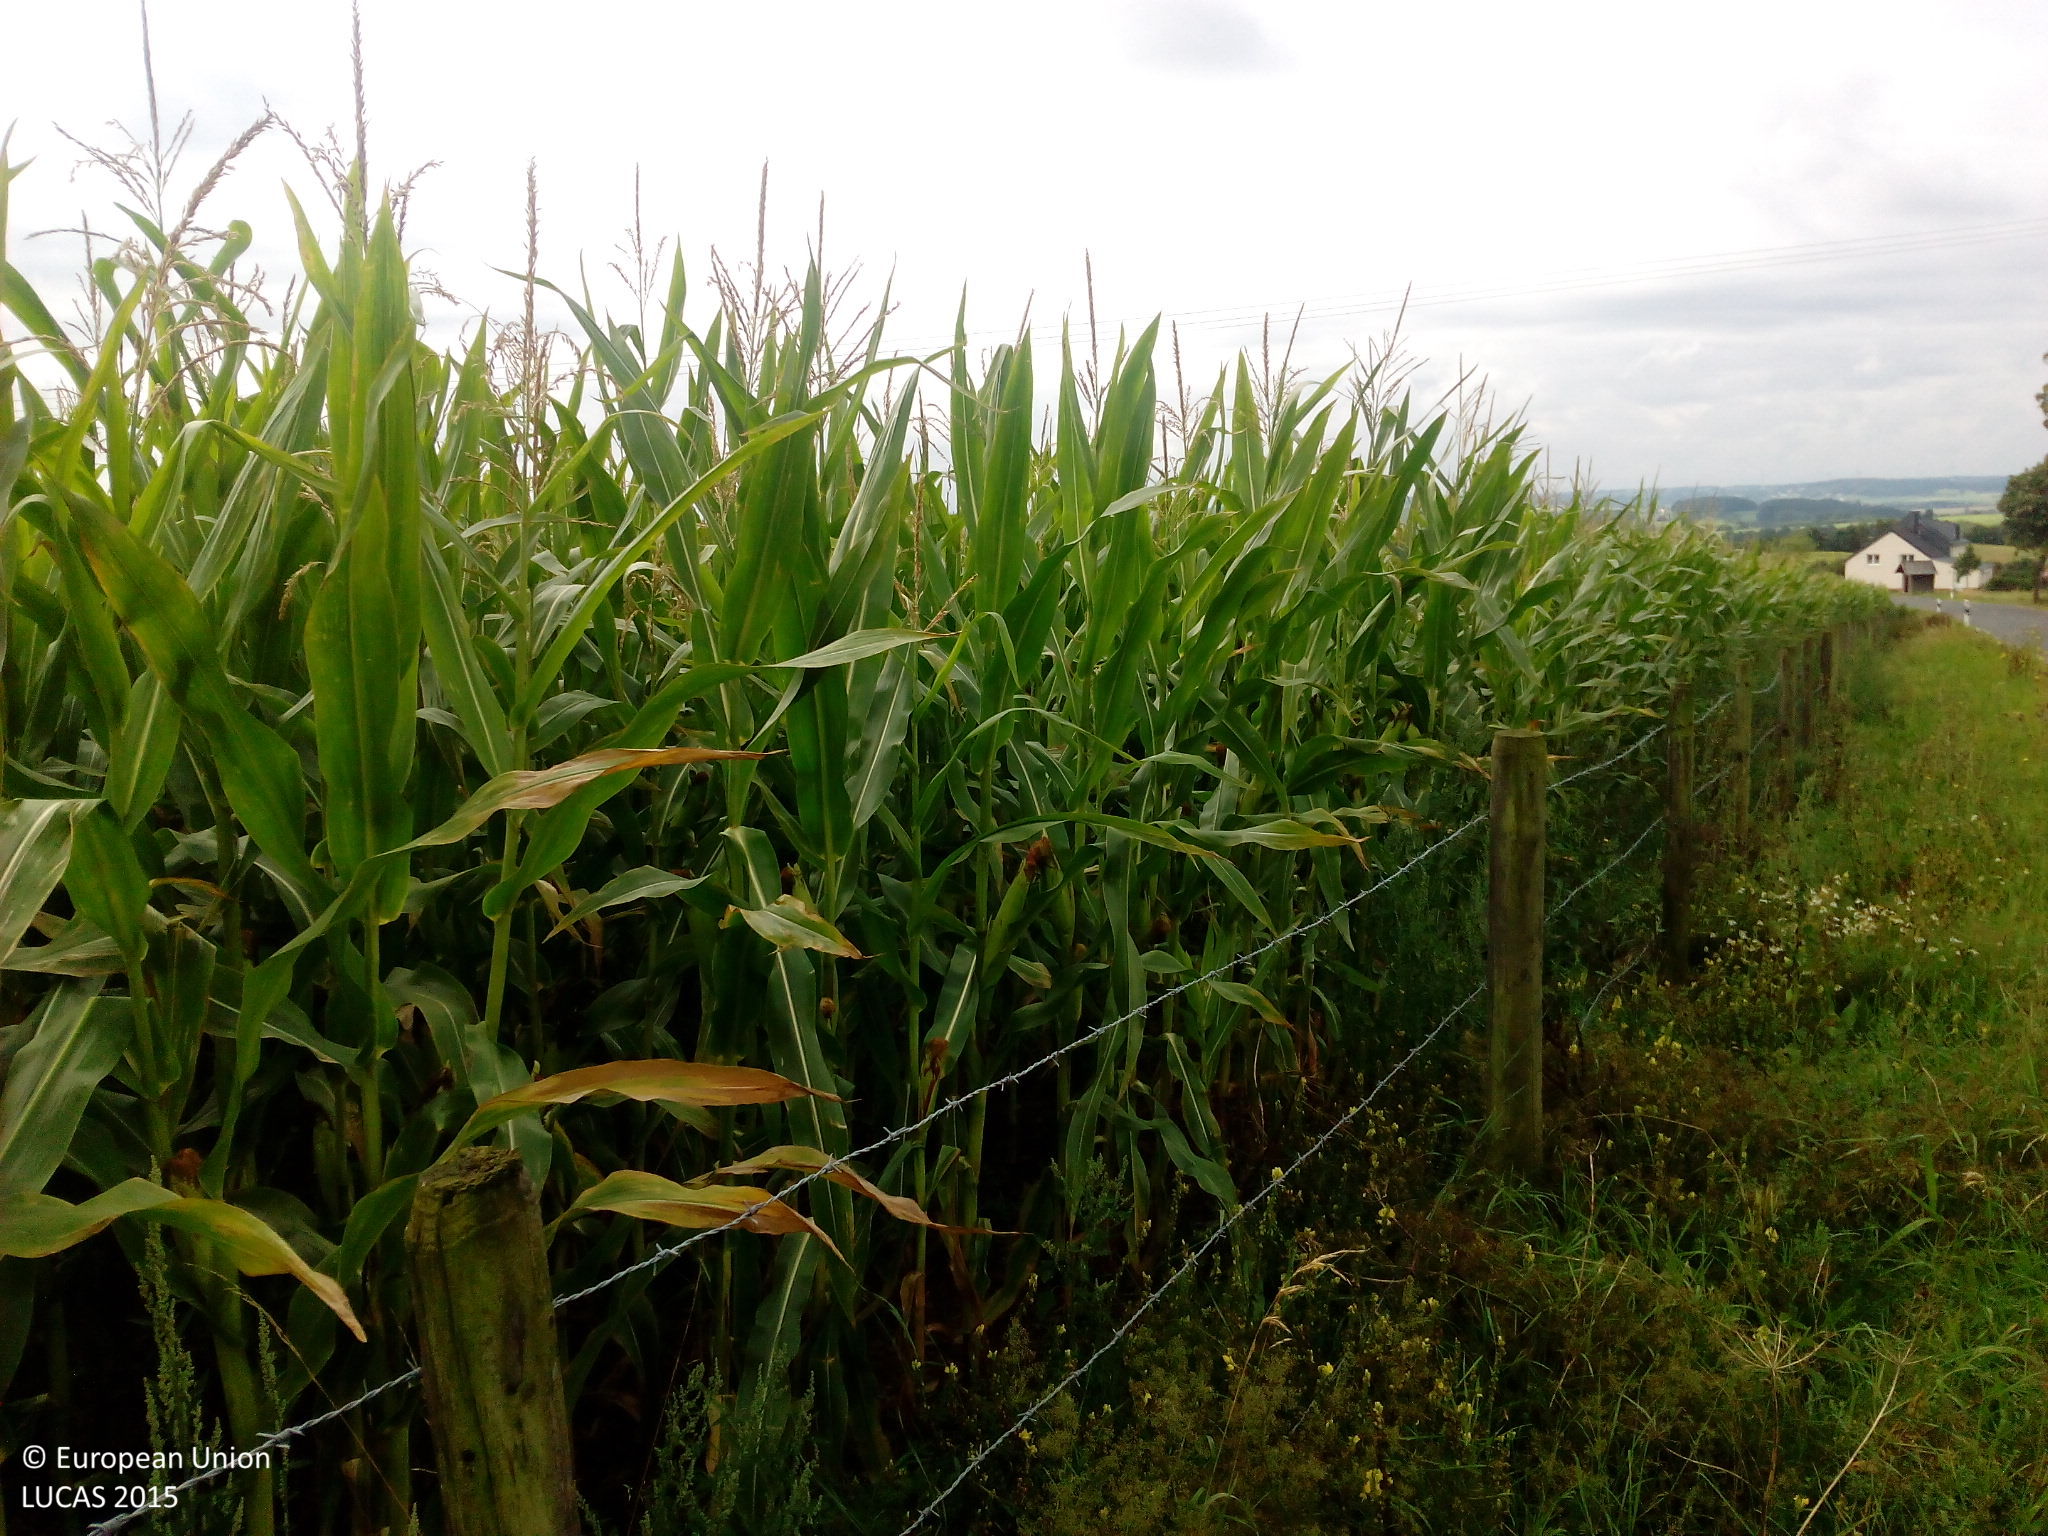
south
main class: Cropland
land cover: Maize
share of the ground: > 75 %
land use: Agriculture (excluding fallow land and kitchen gardens)
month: August
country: DE
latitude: 50.2497
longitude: 6.2830
